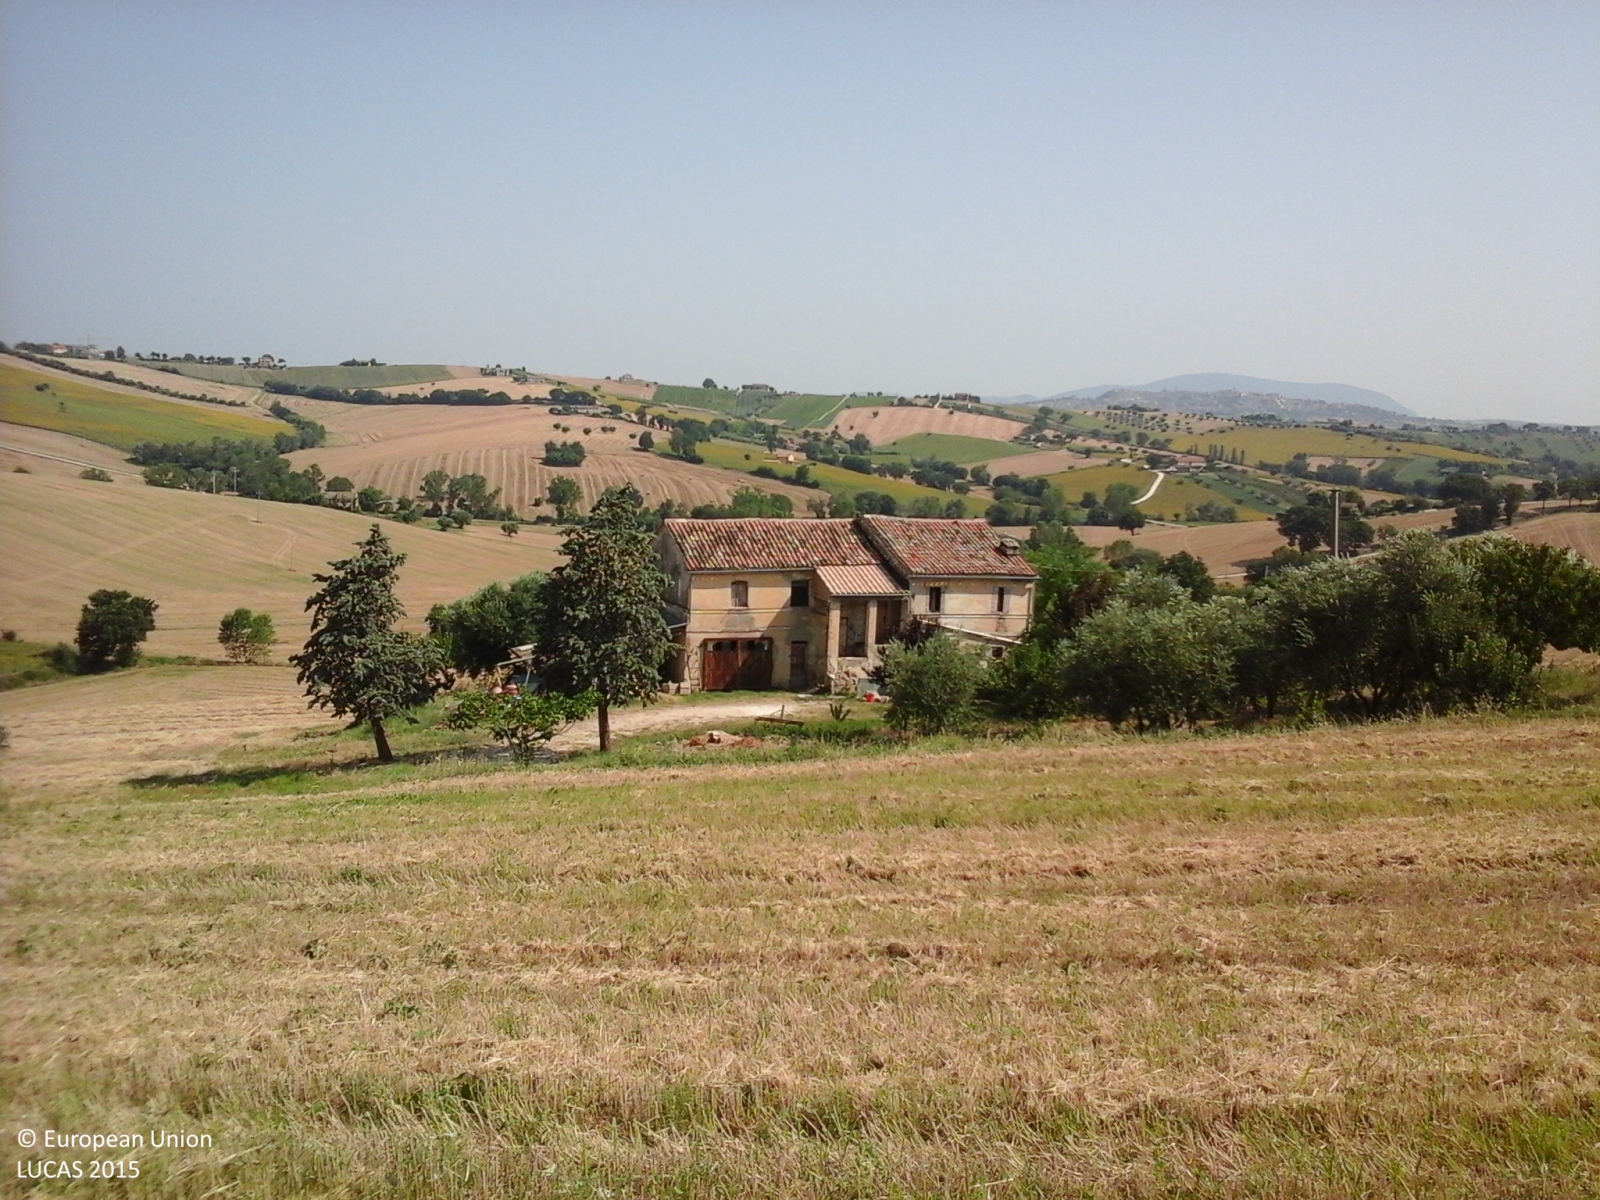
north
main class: Cropland
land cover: Durum wheat
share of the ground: > 75 %
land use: Agriculture (excluding fallow land and kitchen gardens)
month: July
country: IT
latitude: 43.4064
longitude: 13.5106
